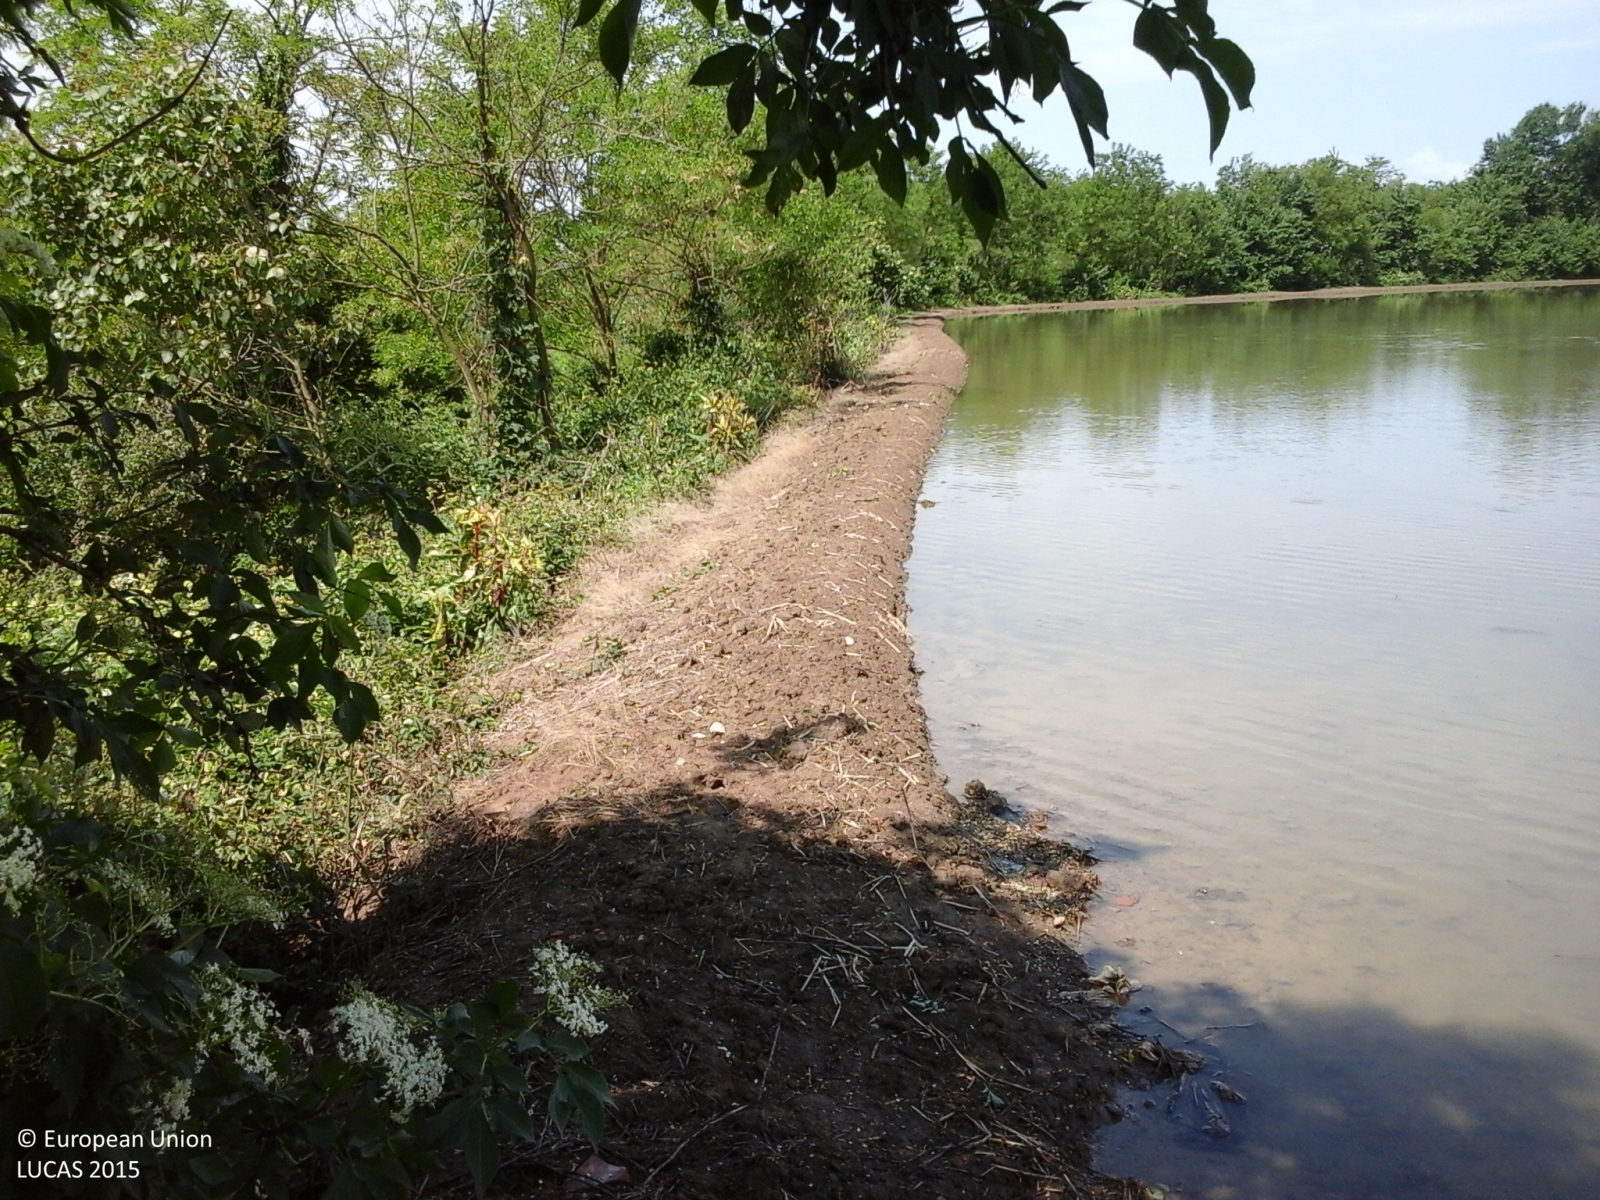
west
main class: Cropland
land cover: Rice
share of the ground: 10 - 25 %
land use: Agriculture (excluding fallow land and kitchen gardens)
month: May
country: IT
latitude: 45.2188
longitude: 8.2076
